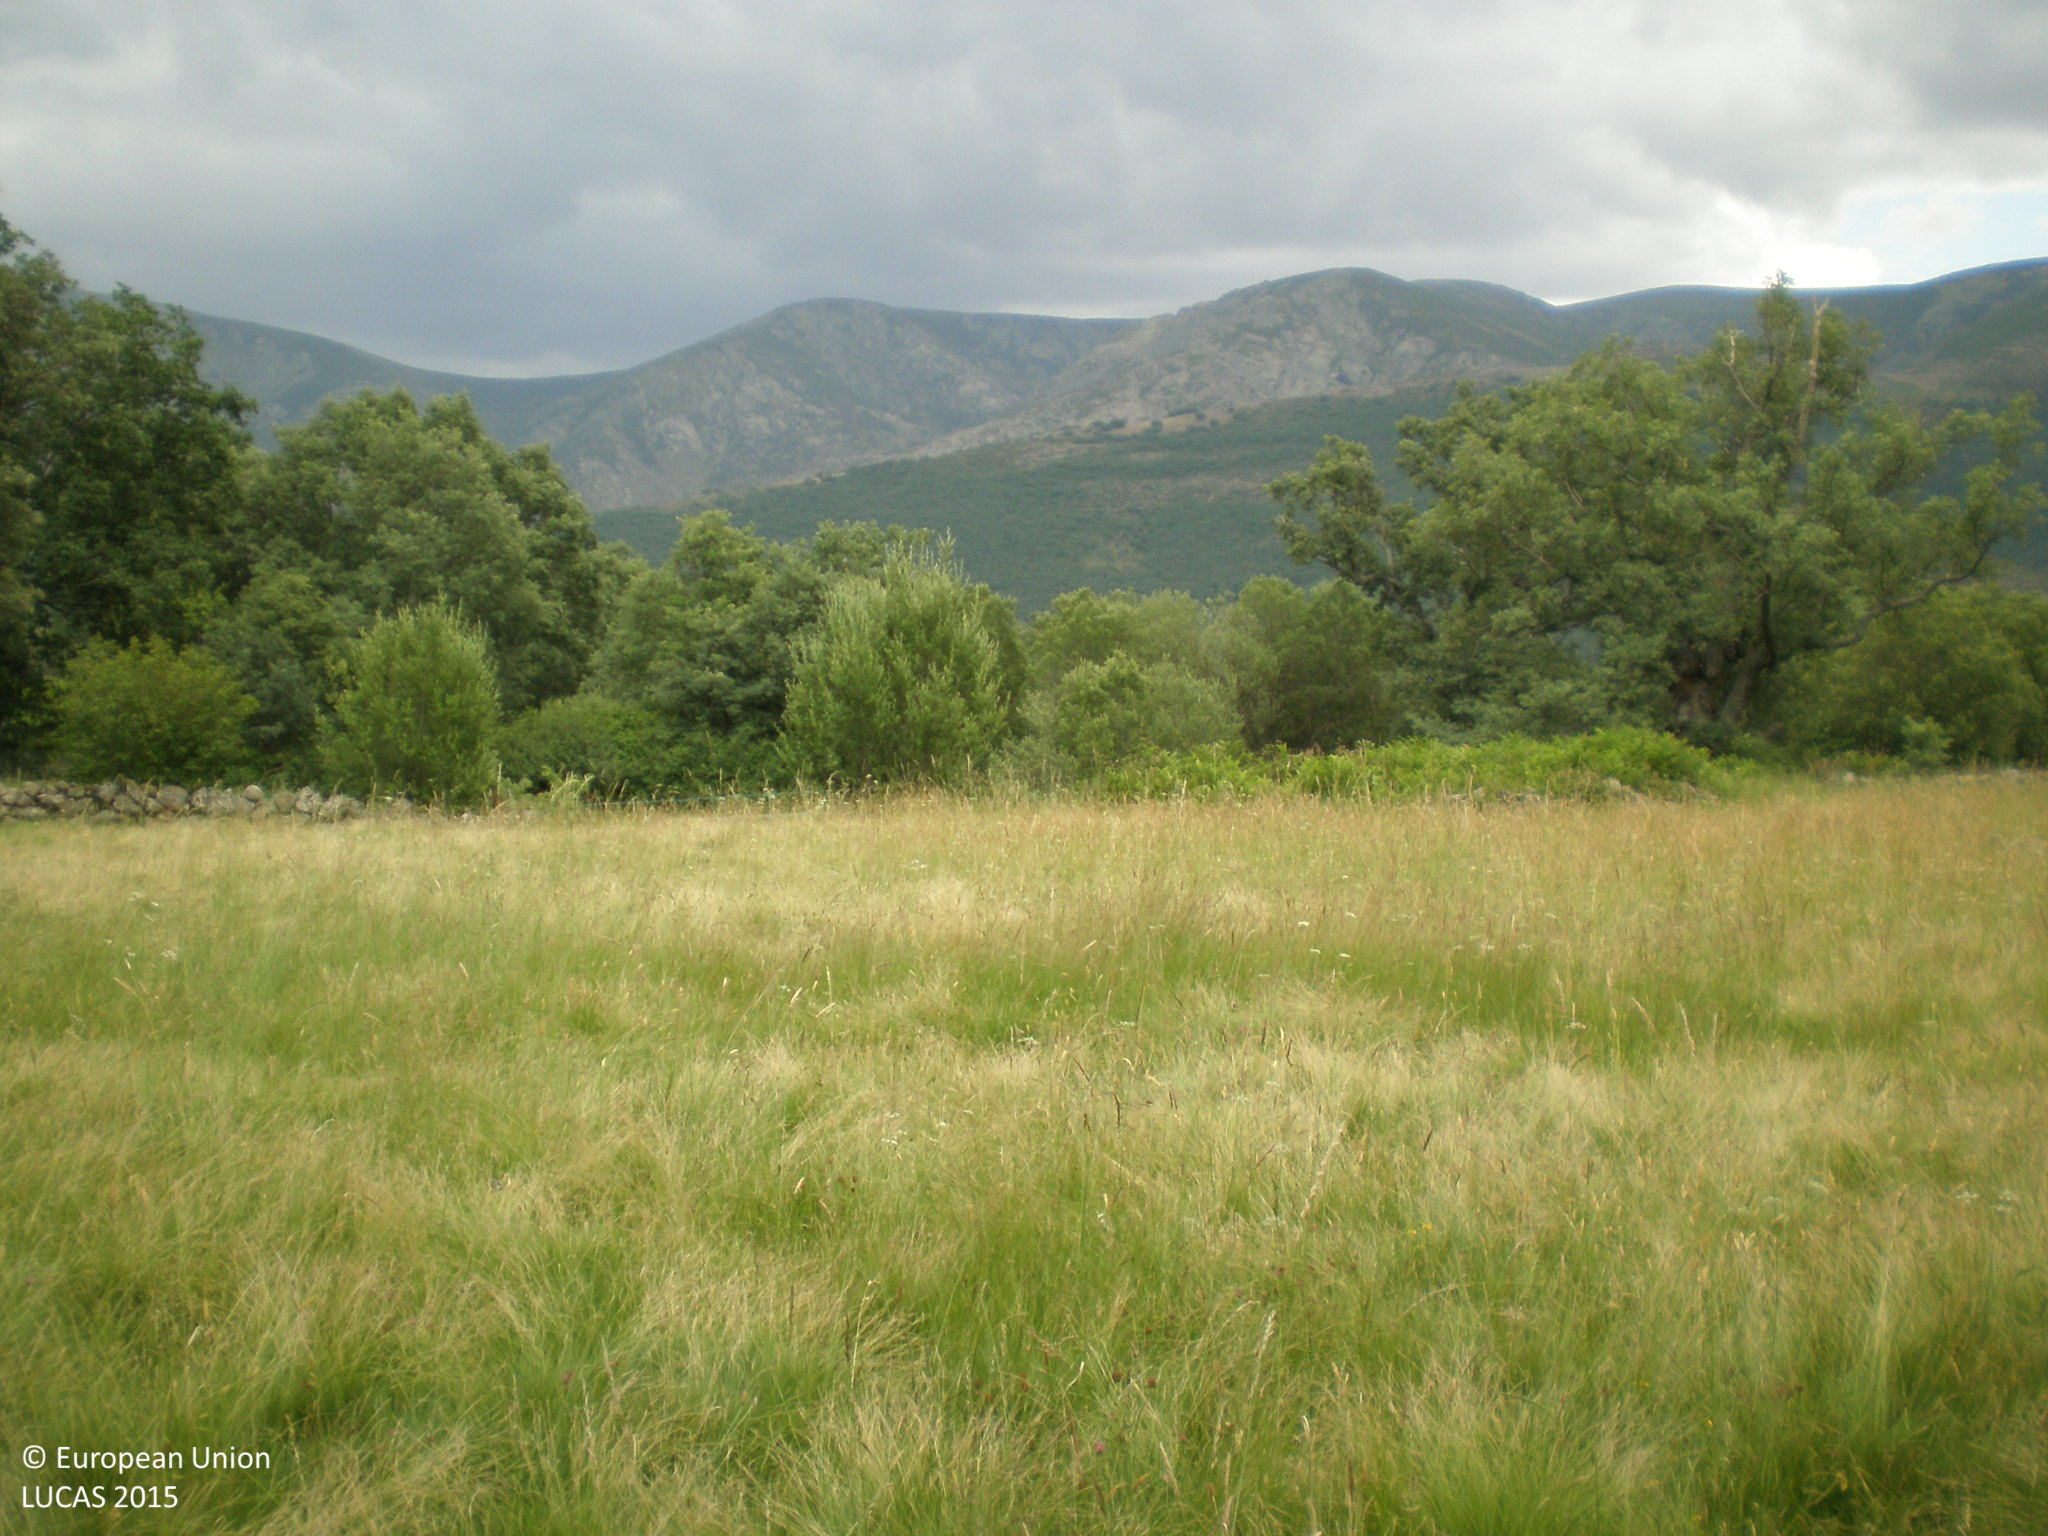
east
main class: Grassland
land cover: Grassland without tree/shrub cover
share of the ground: > 75 %
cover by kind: herbaceous plants 100 %
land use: Agriculture (excluding fallow land and kitchen gardens)
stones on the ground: < 10 %
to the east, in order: Grassland without tree/shrub cover; Dry stone walls; Grassland without tree/shrub cover; Abandoned hedges; Dry stone walls; Grassland without tree/shrub cover; Abandoned hedges; Dry stone walls; Grassland without tree/shrub cover; Dry stone walls; Grassland with sparse tree/shrub cover; Dry stone walls; Broadleaved woodland; Fences; Broadleaved woodland
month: June
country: ES
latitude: 40.2547
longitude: -5.5247
